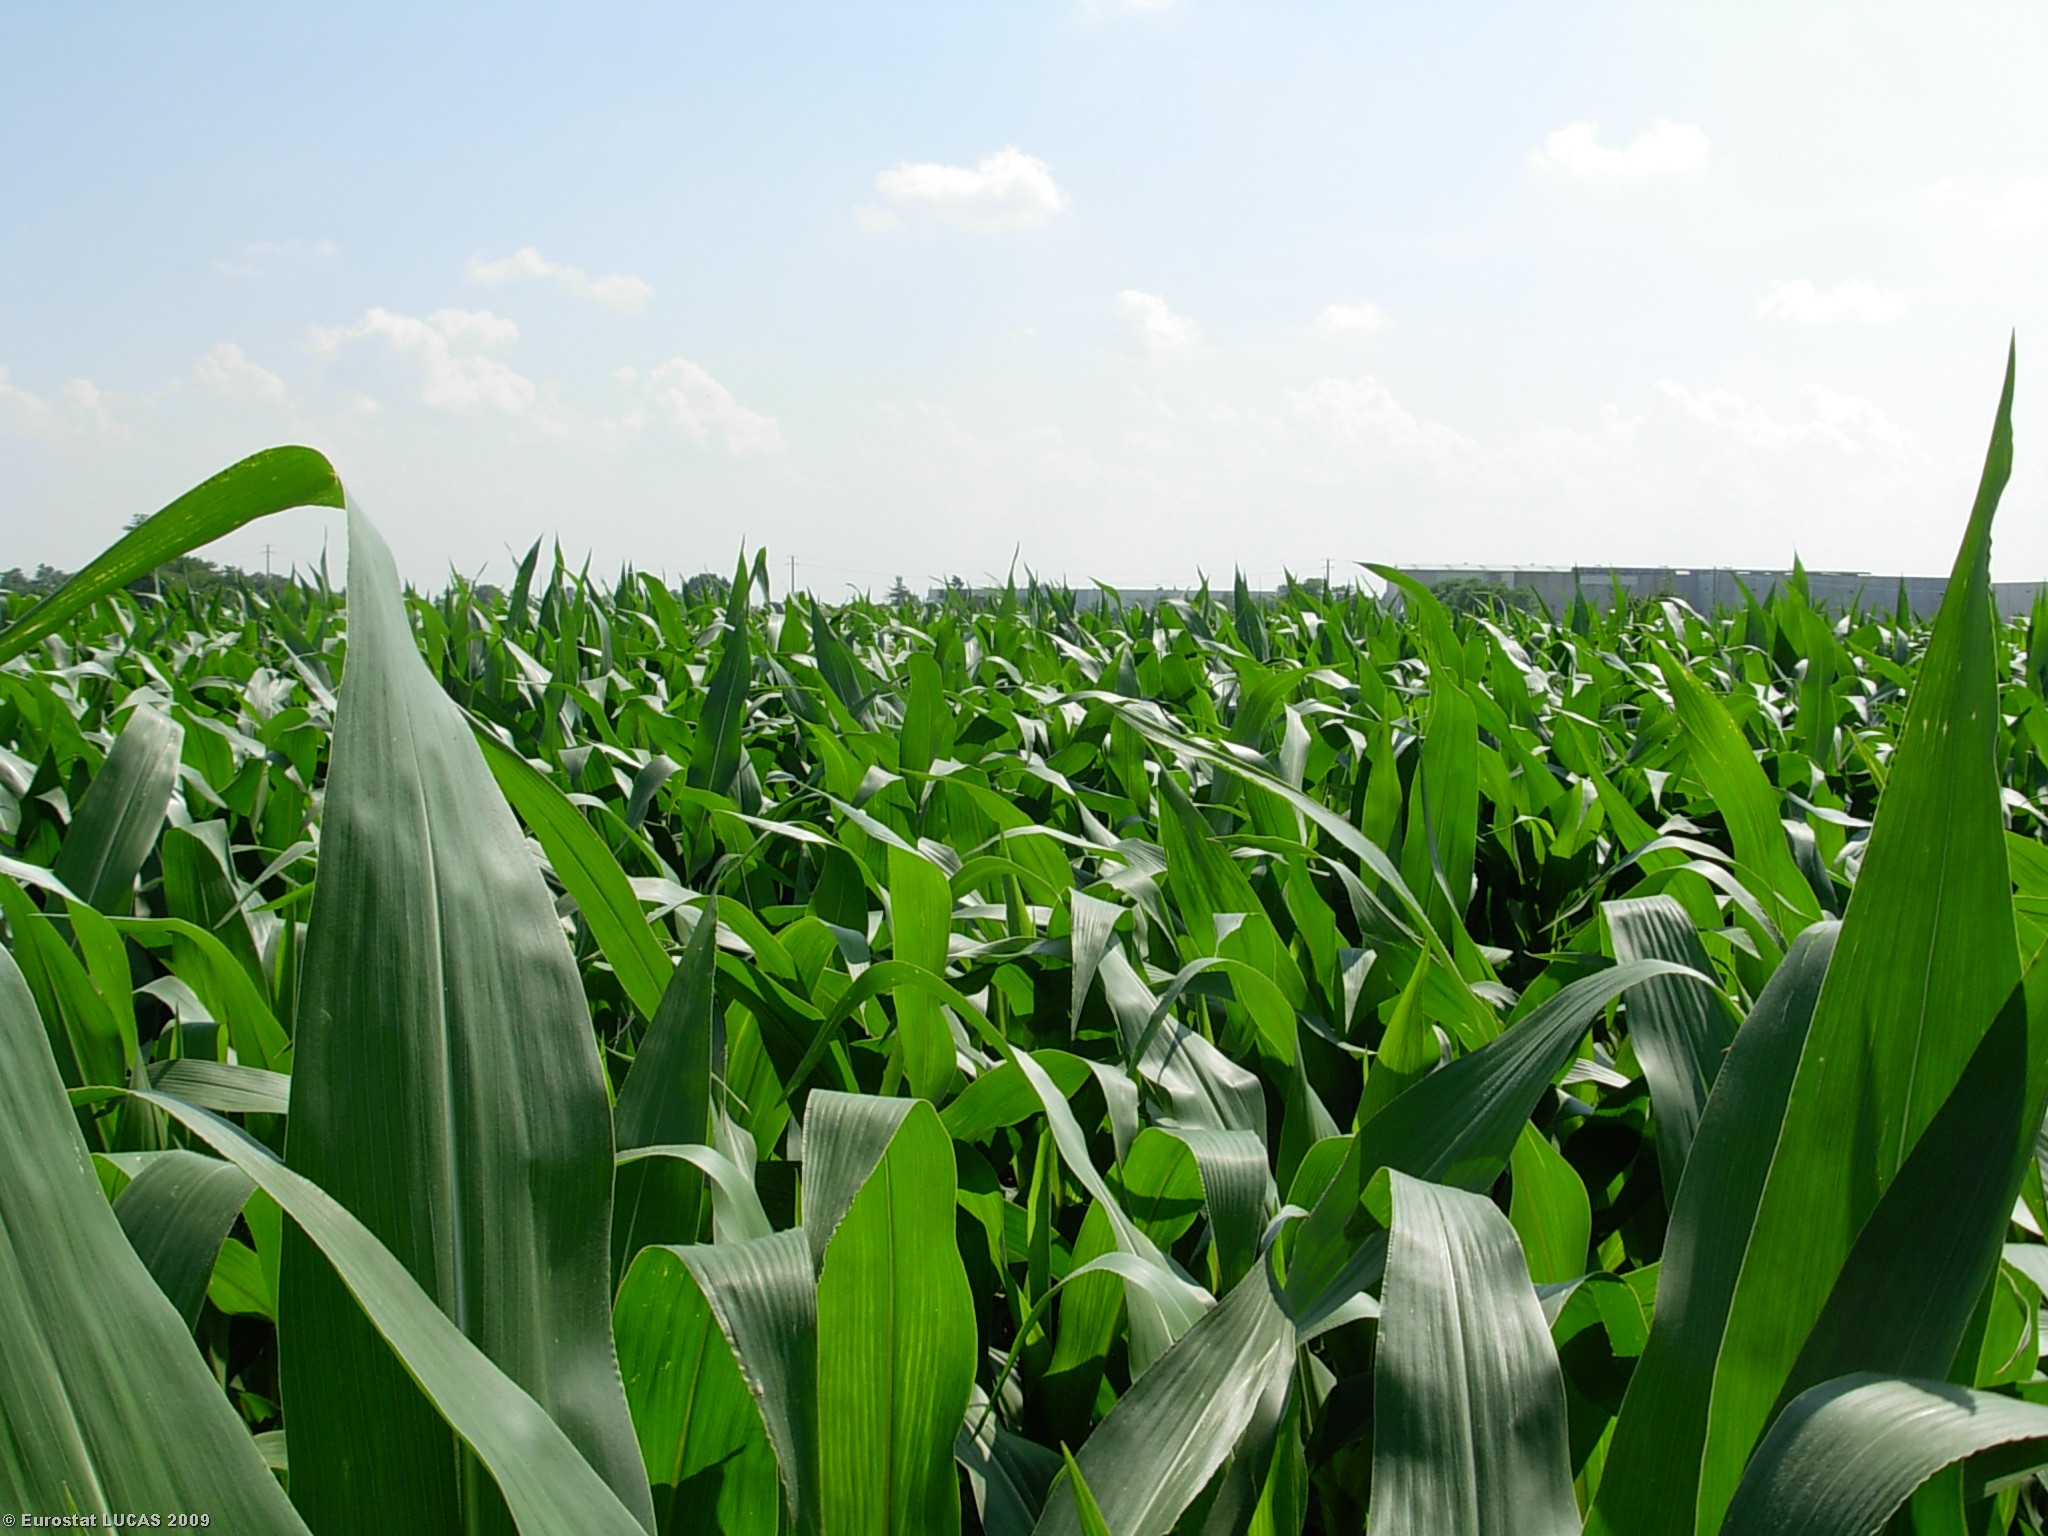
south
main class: Cropland
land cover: Maize
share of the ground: > 75 %
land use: Agriculture (excluding fallow land and kitchen gardens)
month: June
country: IT
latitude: 45.5035
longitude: 10.4472
